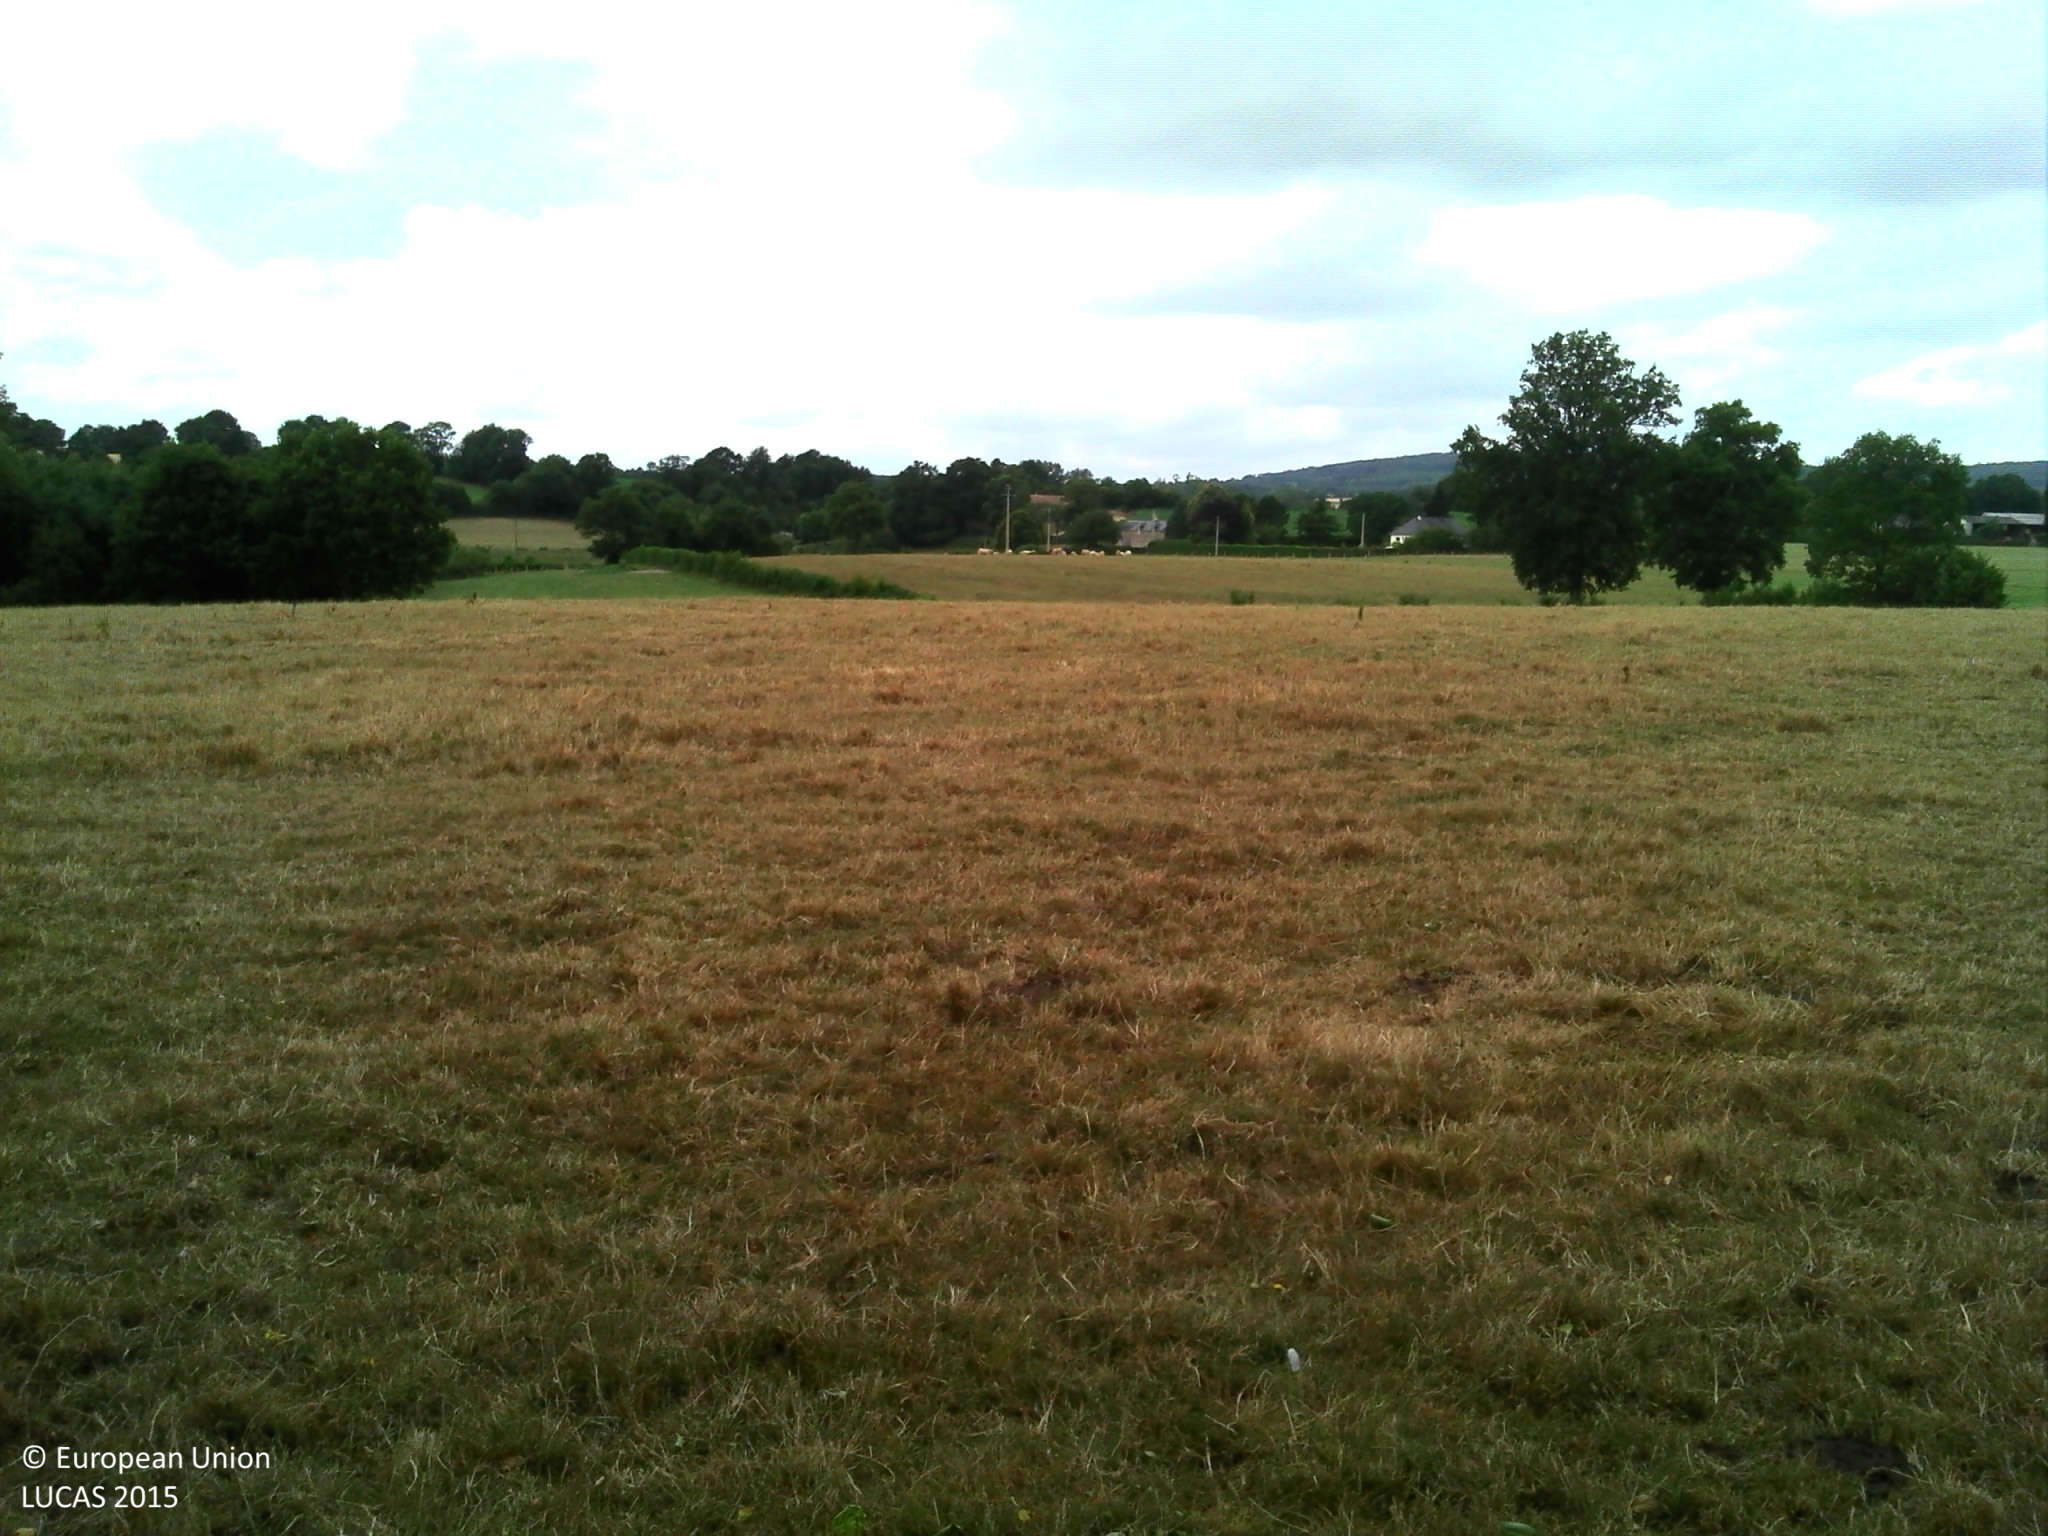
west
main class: Grassland
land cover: Grassland without tree/shrub cover
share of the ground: > 75 %
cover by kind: herbaceous plants 100 %
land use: Agriculture (excluding fallow land and kitchen gardens)
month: July
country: FR
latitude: 48.4117
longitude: -0.0954
